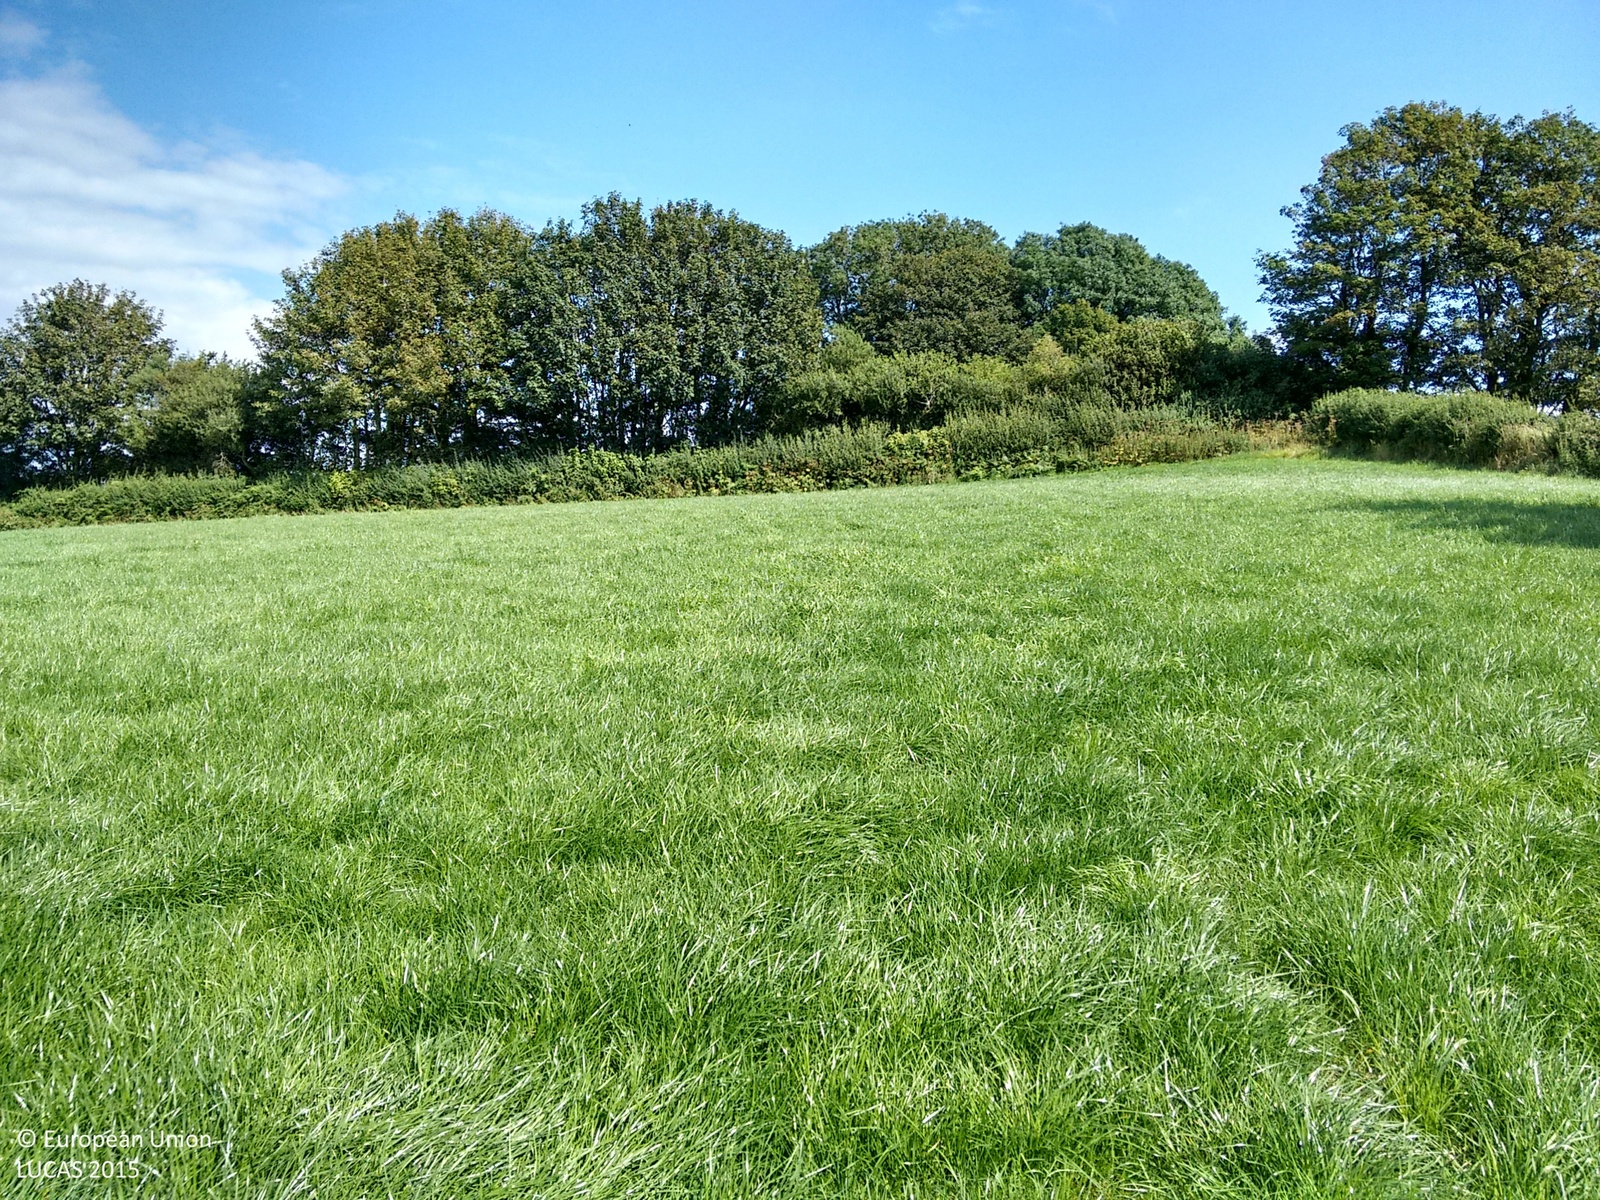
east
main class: Grassland
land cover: Grassland without tree/shrub cover
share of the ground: > 75 %
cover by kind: herbaceous plants 100 %
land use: Agriculture (excluding fallow land and kitchen gardens)
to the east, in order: Grassland without tree/shrub cover; Fences; Managed hedges; Grassland without tree/shrub cover; Broadleaved woodland; Fences; Grassland without tree/shrub cover; Single bushes/trees; Grassland without tree/shrub cover; Single bushes/trees; Grassland without tree/shrub cover
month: August
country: GB
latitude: 51.7947
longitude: -4.4738
